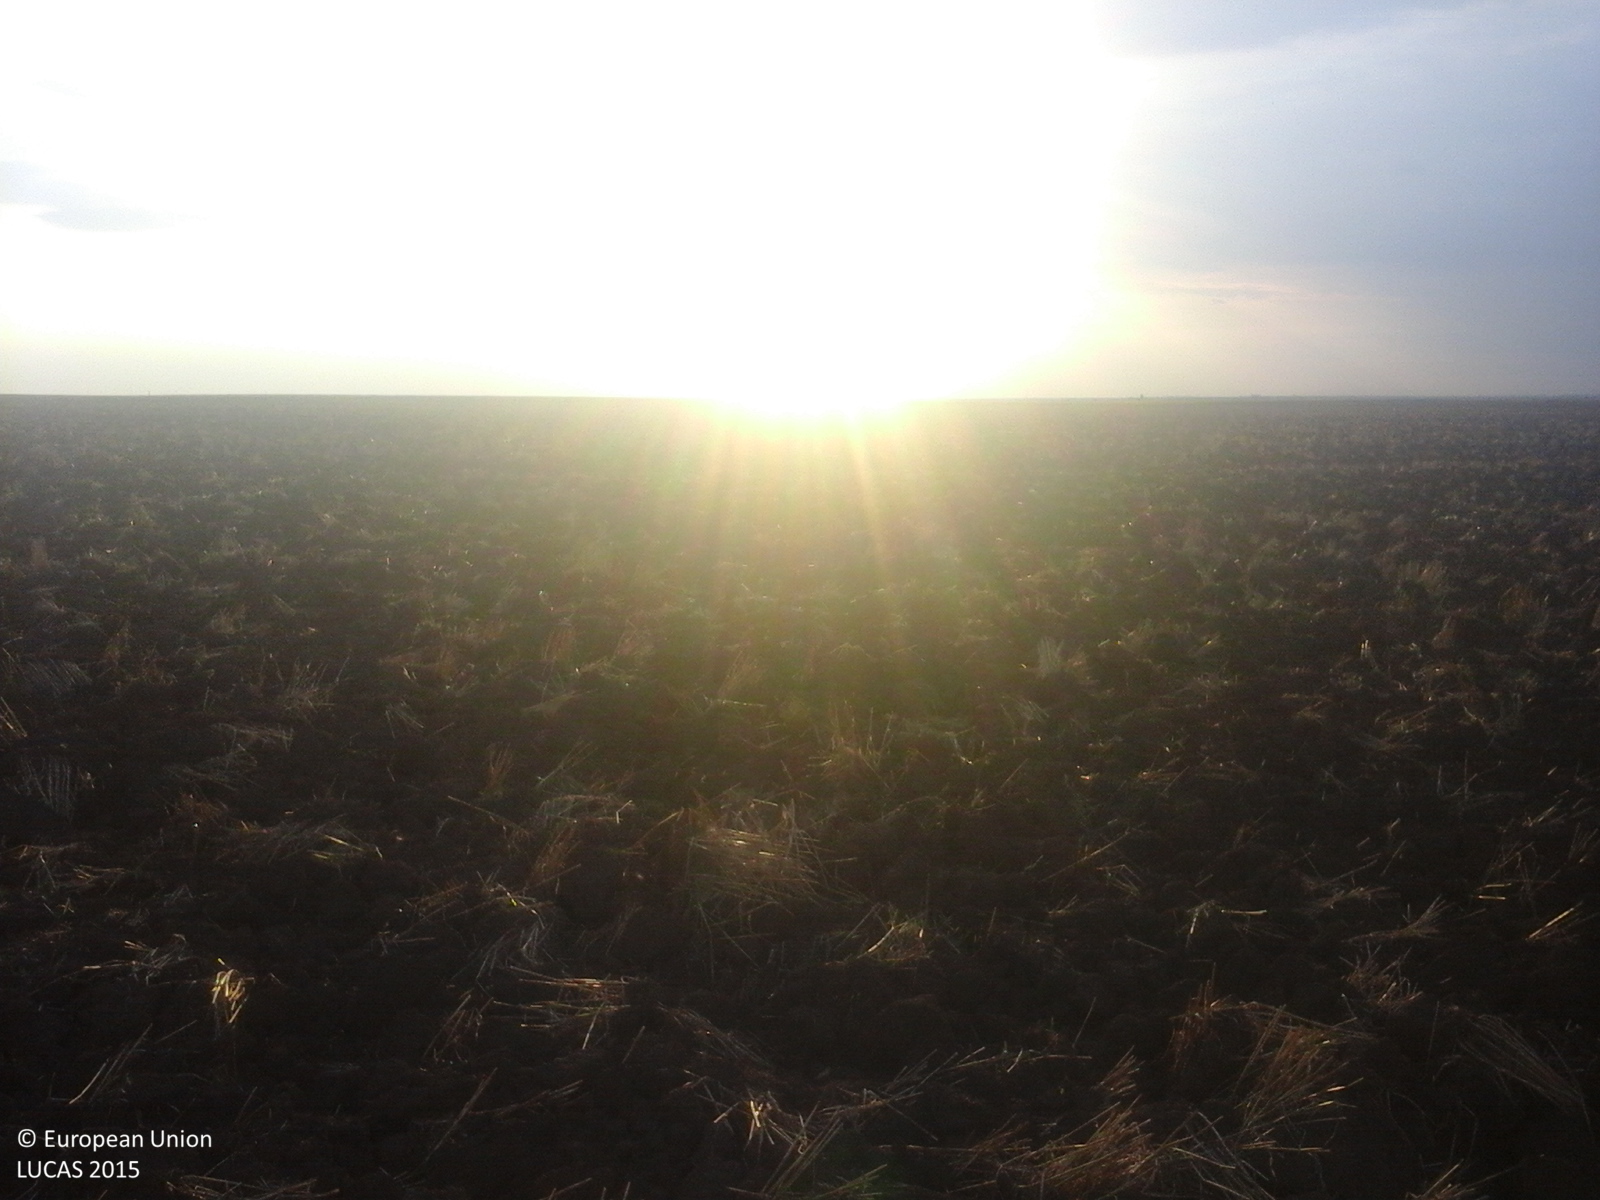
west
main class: Cropland
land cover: Common wheat
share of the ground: < 10 %
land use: Agriculture (excluding fallow land and kitchen gardens)
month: July
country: RO
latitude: 43.8341
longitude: 24.5288
